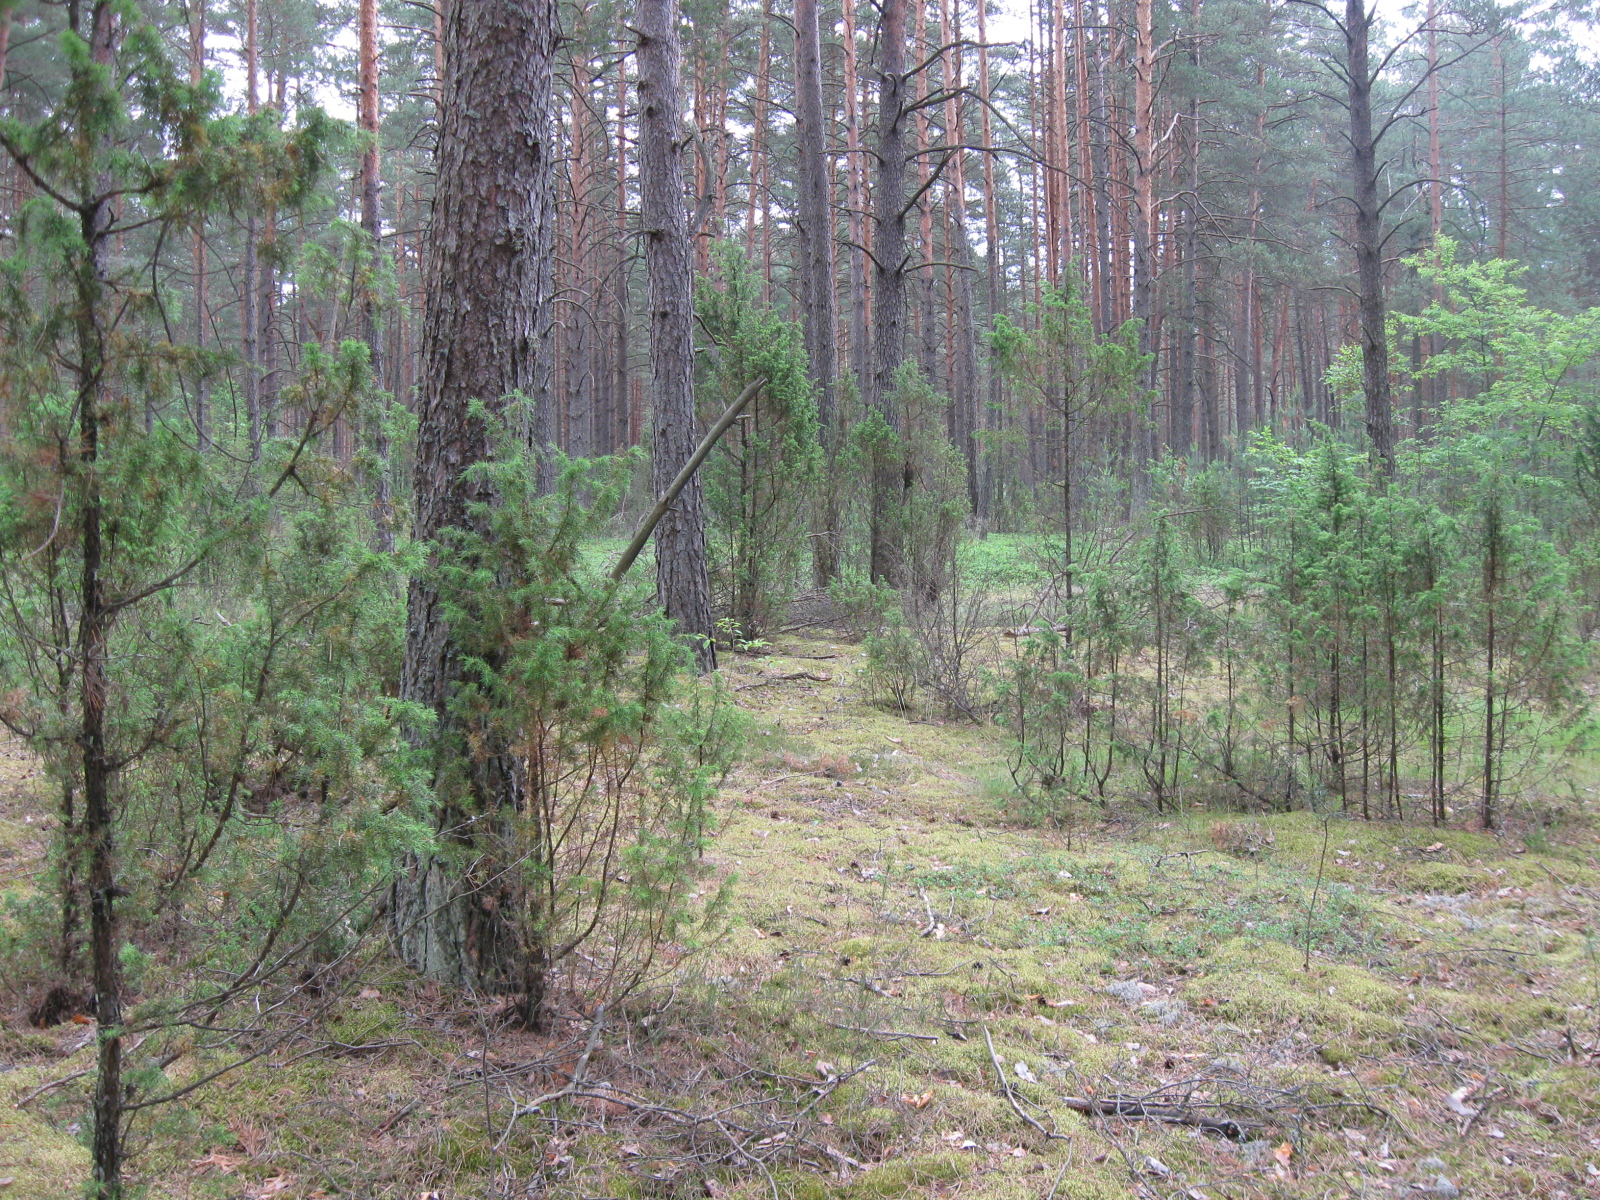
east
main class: Woodland
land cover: Pine dominated coniferous woodland
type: hemiboreal forest and nemoral coniferous forest and mixed broadleaved-coniferous forest
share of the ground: > 75 %
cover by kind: coniferous forest trees 95 %, lichens and mosses 5 %
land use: Forestry
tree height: > 5 m
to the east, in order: Pine dominated coniferous woodland; Tracks; Pine dominated coniferous woodland; Pine dominated mixed woodland; Tracks; Pine dominated mixed woodland
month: July
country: LT
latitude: 54.1775
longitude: 24.2704
